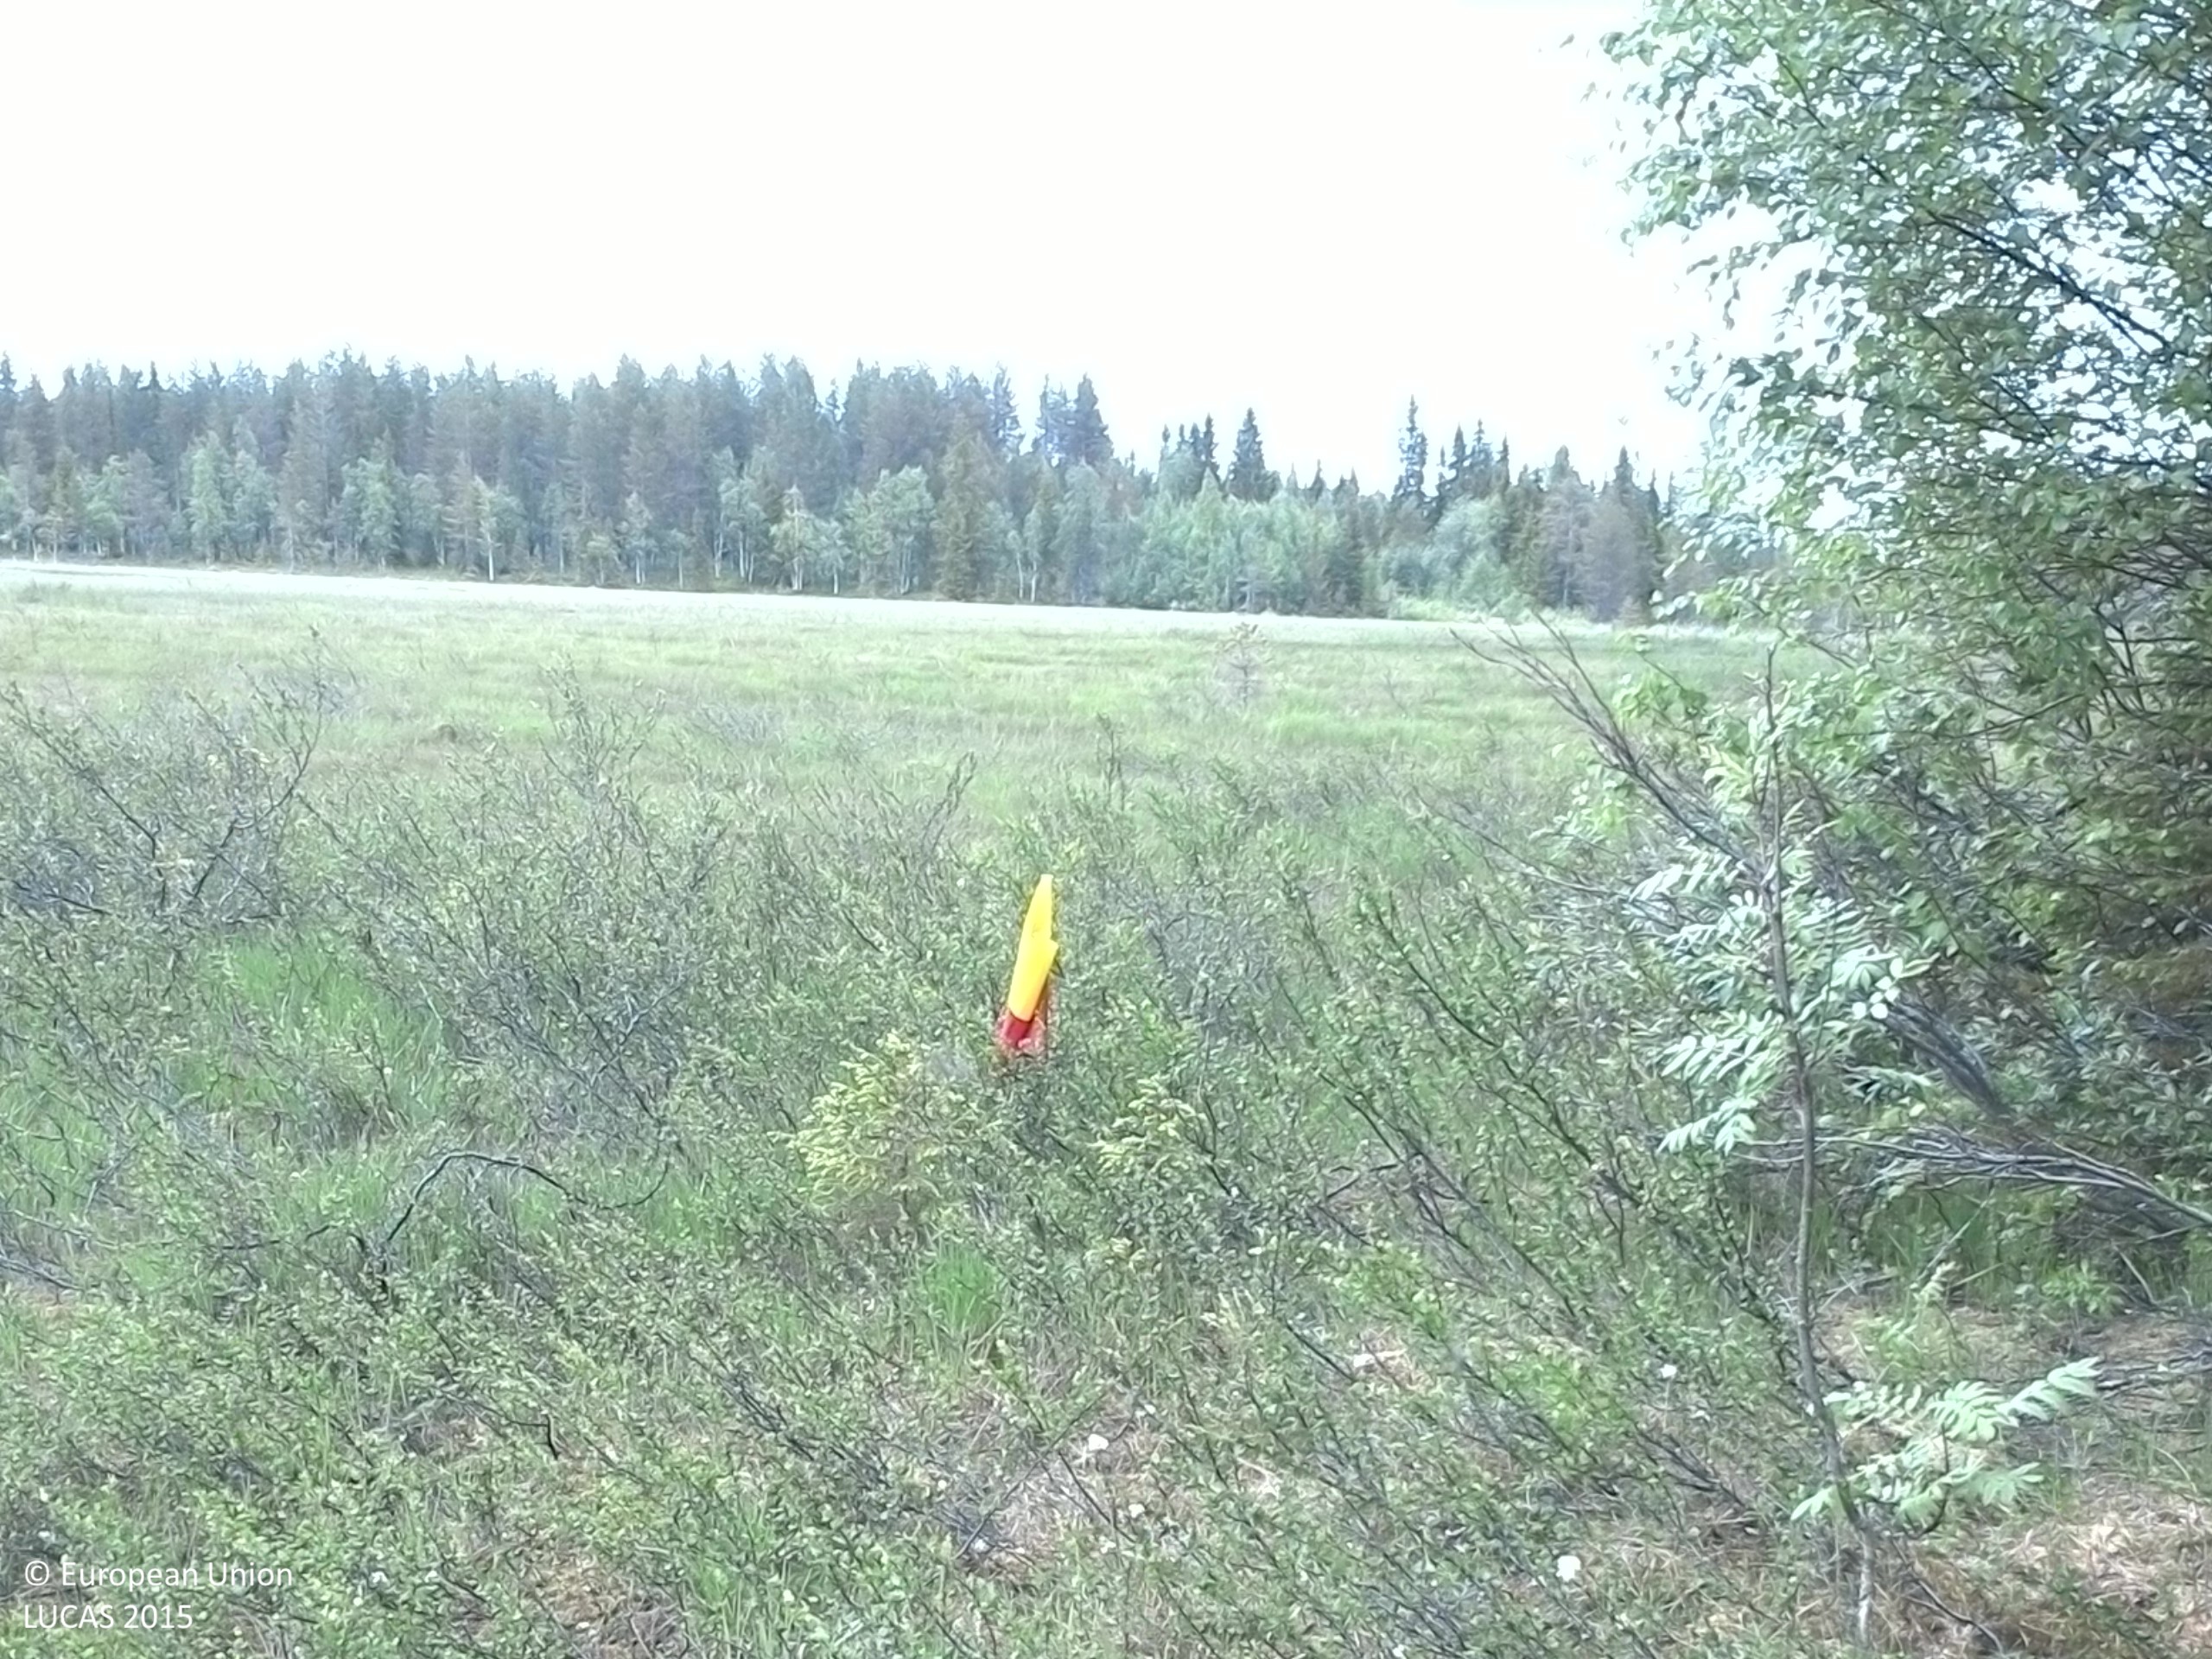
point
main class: Shrubland
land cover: Shrubland with sparse tree cover
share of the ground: 50 - 75 %
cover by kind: shrubs 70 %, herbaceous plants 15 %, lichens and mosses 10 %, broadleaved forest trees 5 %
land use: Semi-natural and natural areas not in use
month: July
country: SE
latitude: 64.3755
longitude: 16.4554
